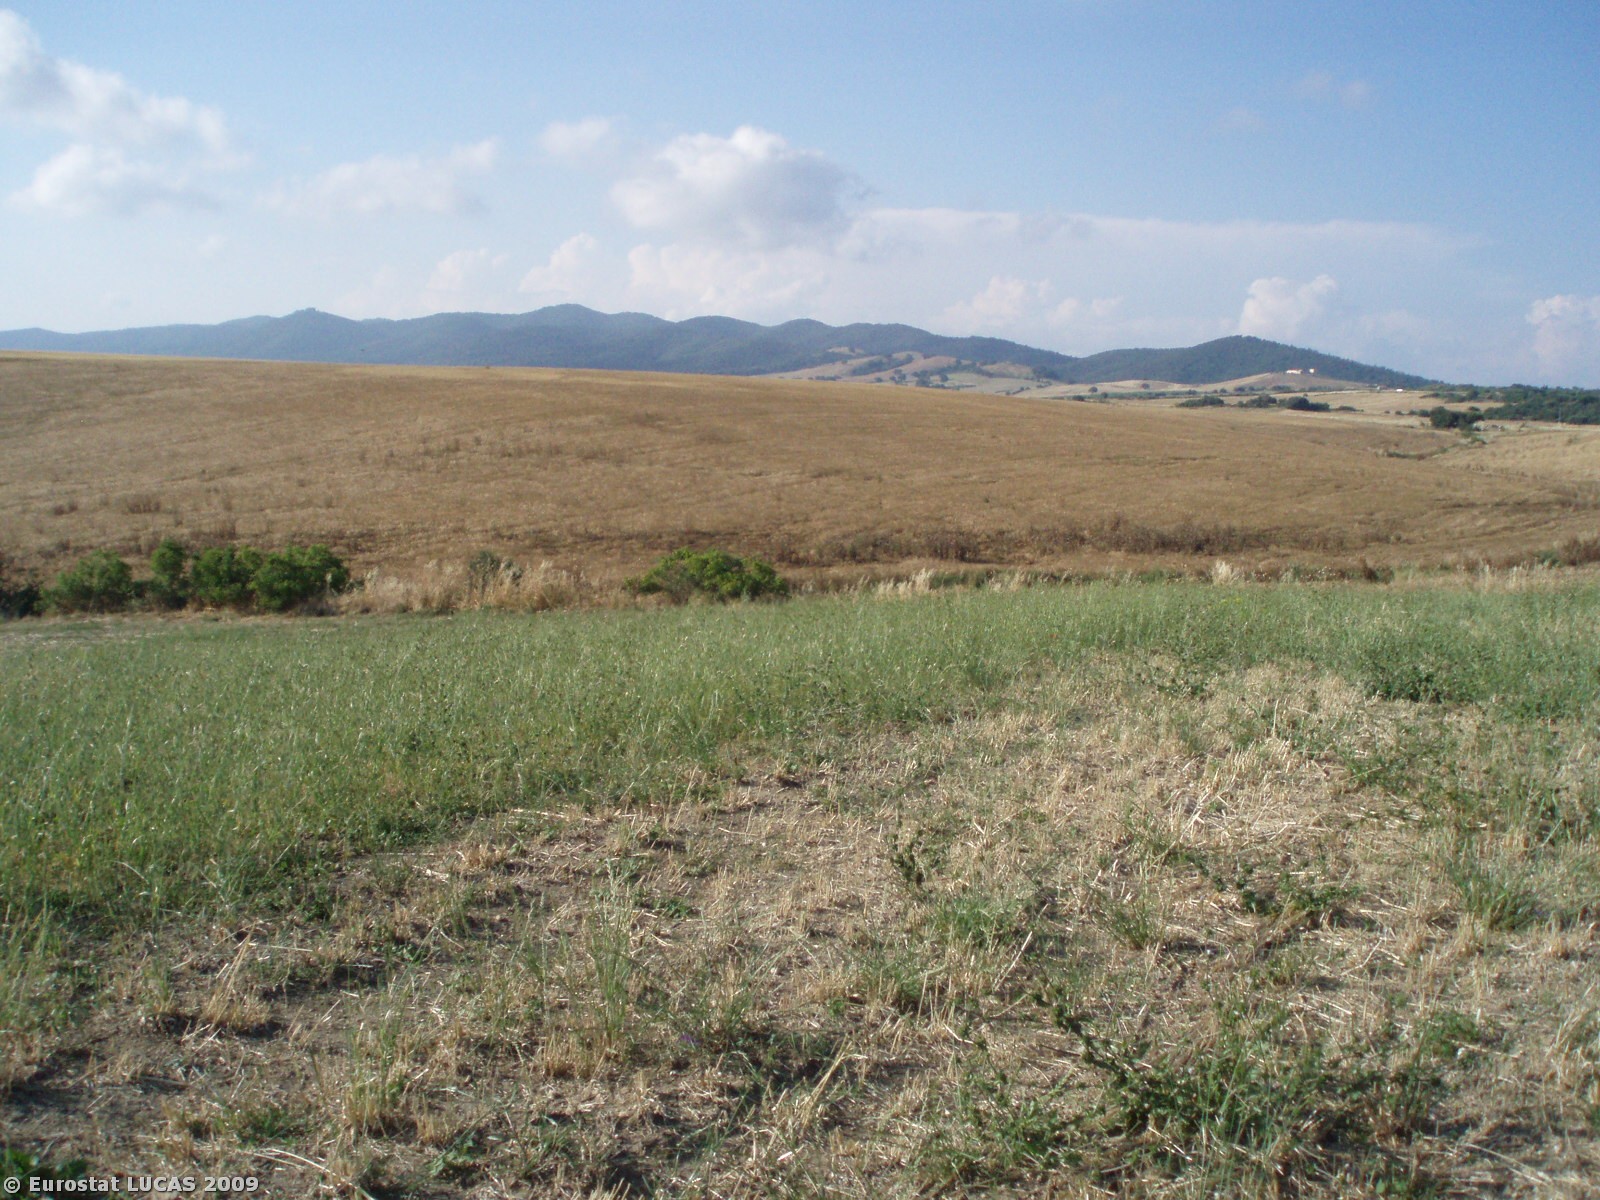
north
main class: Cropland
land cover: Temporary grasslands
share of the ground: > 75 %
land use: Agriculture (excluding fallow land and kitchen gardens)
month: June
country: IT
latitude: 42.4429
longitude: 11.5871
